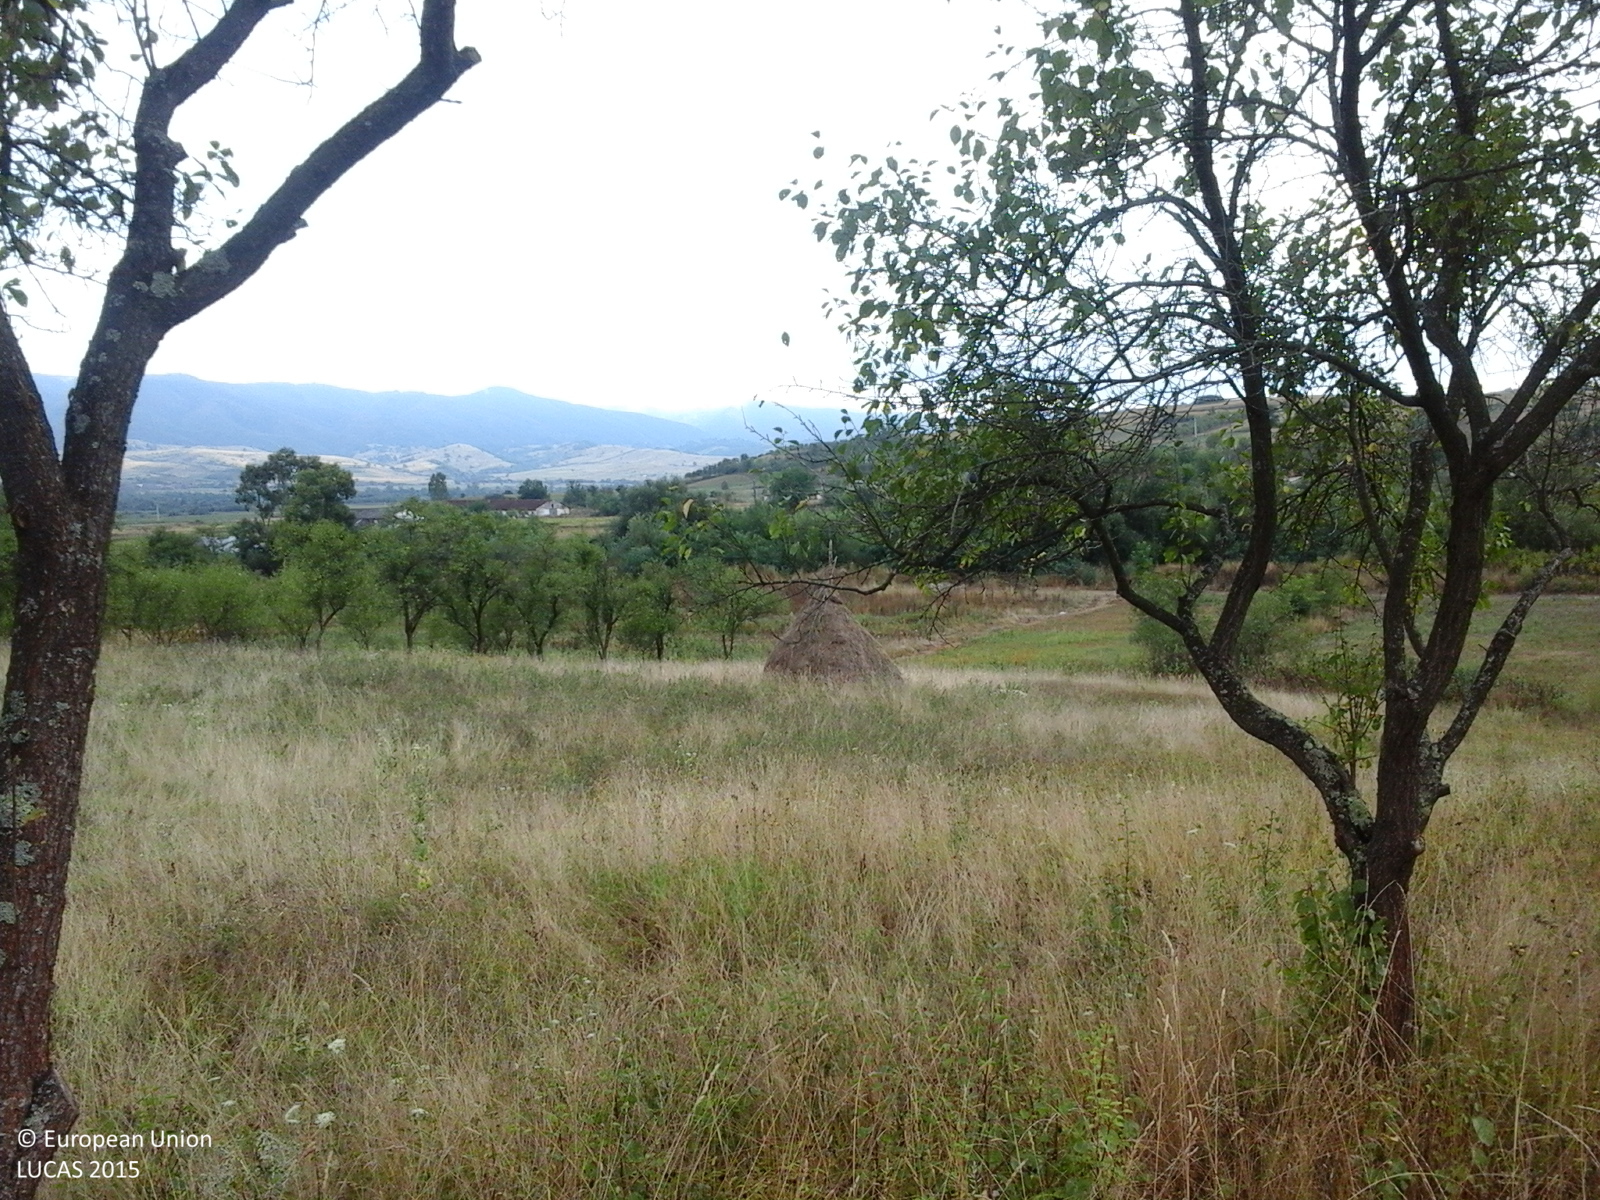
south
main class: Cropland
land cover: Nuts trees
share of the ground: 25 - 50 %
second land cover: Grassland without tree/shrub cover
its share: > 75 %
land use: Agriculture (excluding fallow land and kitchen gardens)
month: August
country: RO
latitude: 44.8959
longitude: 21.9498
